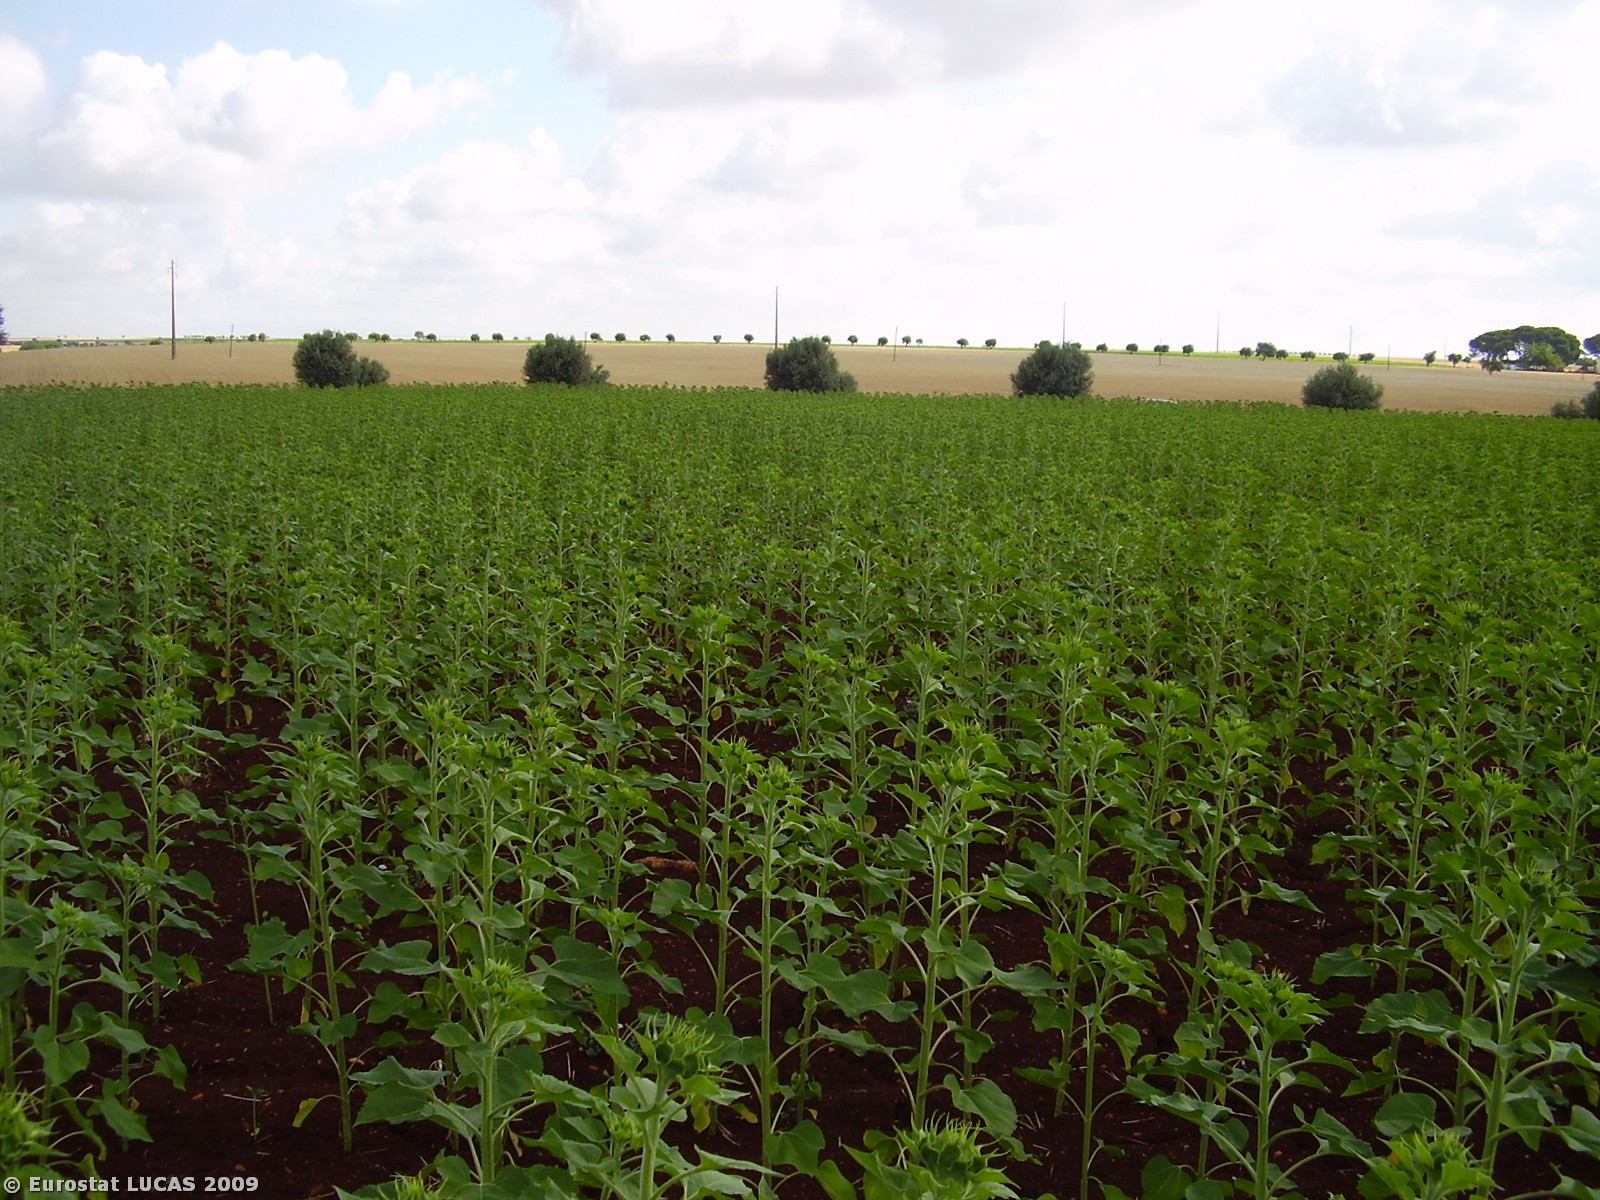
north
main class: Cropland
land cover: Sunflower
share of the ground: 50 - 75 %
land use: Agriculture (excluding fallow land and kitchen gardens)
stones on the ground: < 10 %
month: May
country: PT
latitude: 37.9298
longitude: -7.7605
